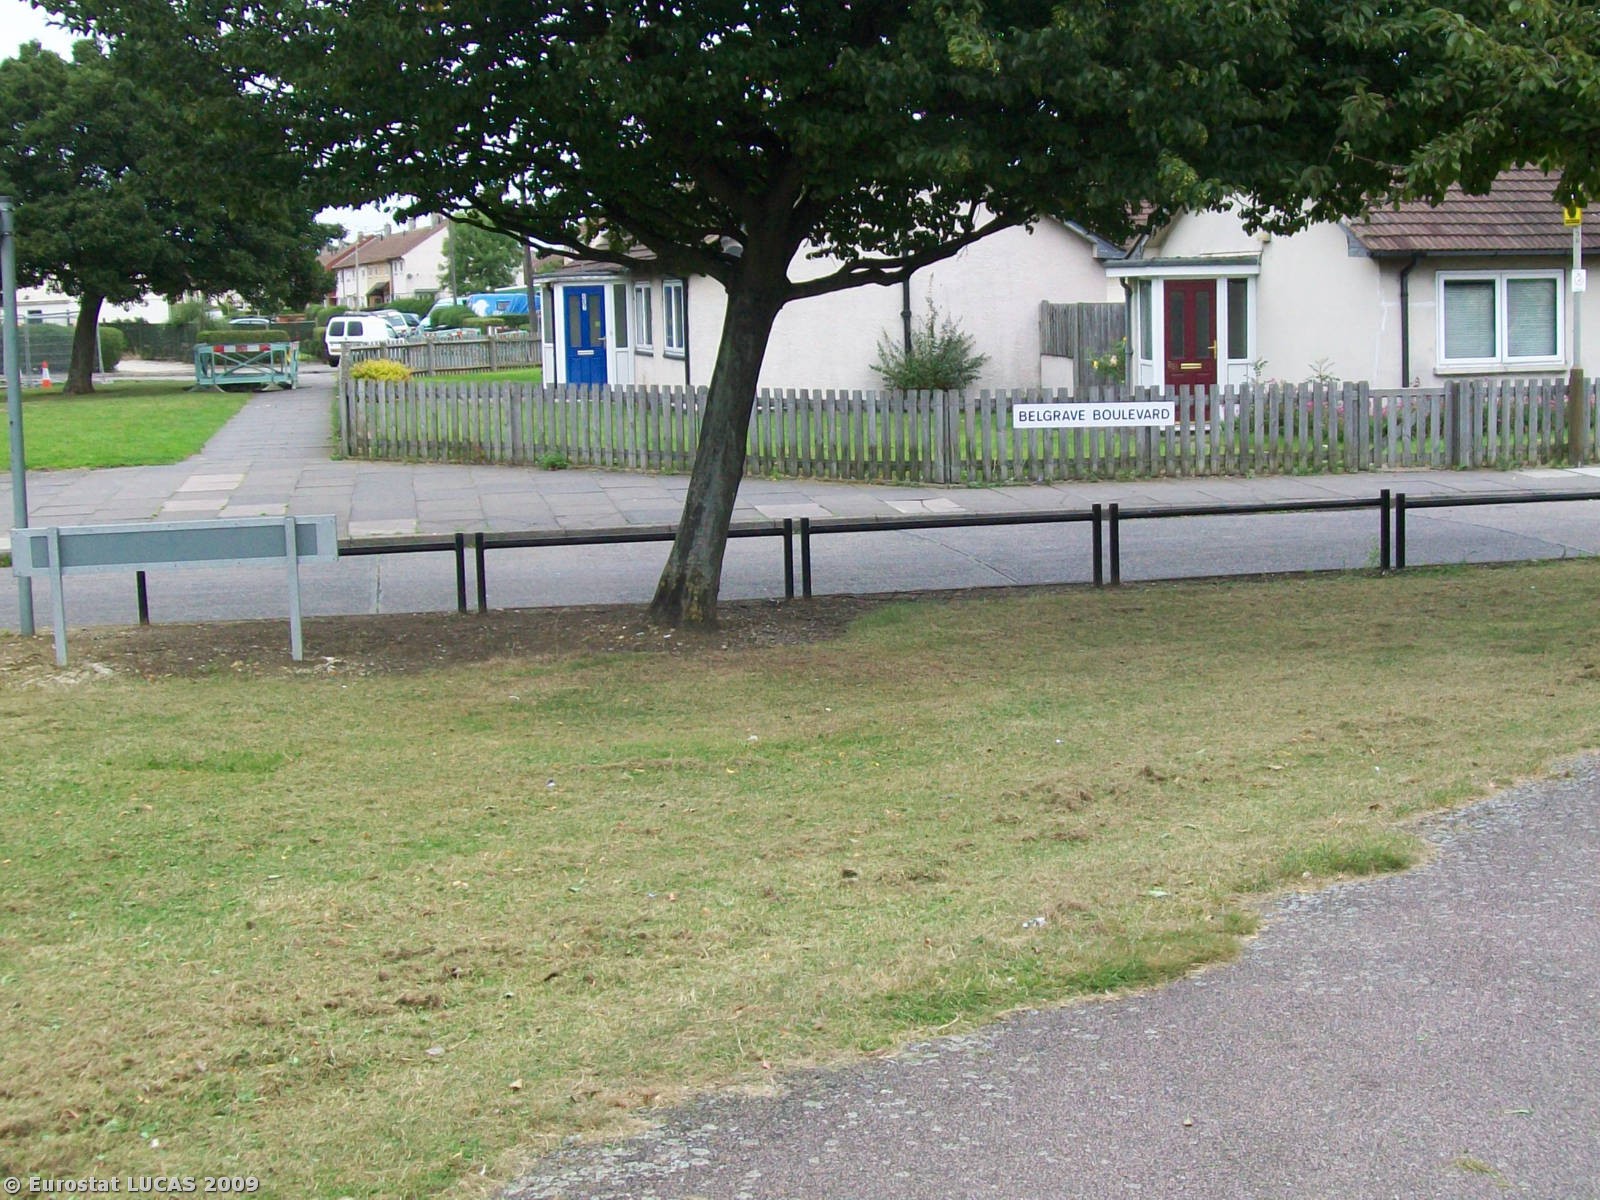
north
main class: Grassland
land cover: Grassland with sparse tree/shrub cover
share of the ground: > 75 %
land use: Unused
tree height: > 5 m
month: September
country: GB
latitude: 52.6672
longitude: -1.1511
